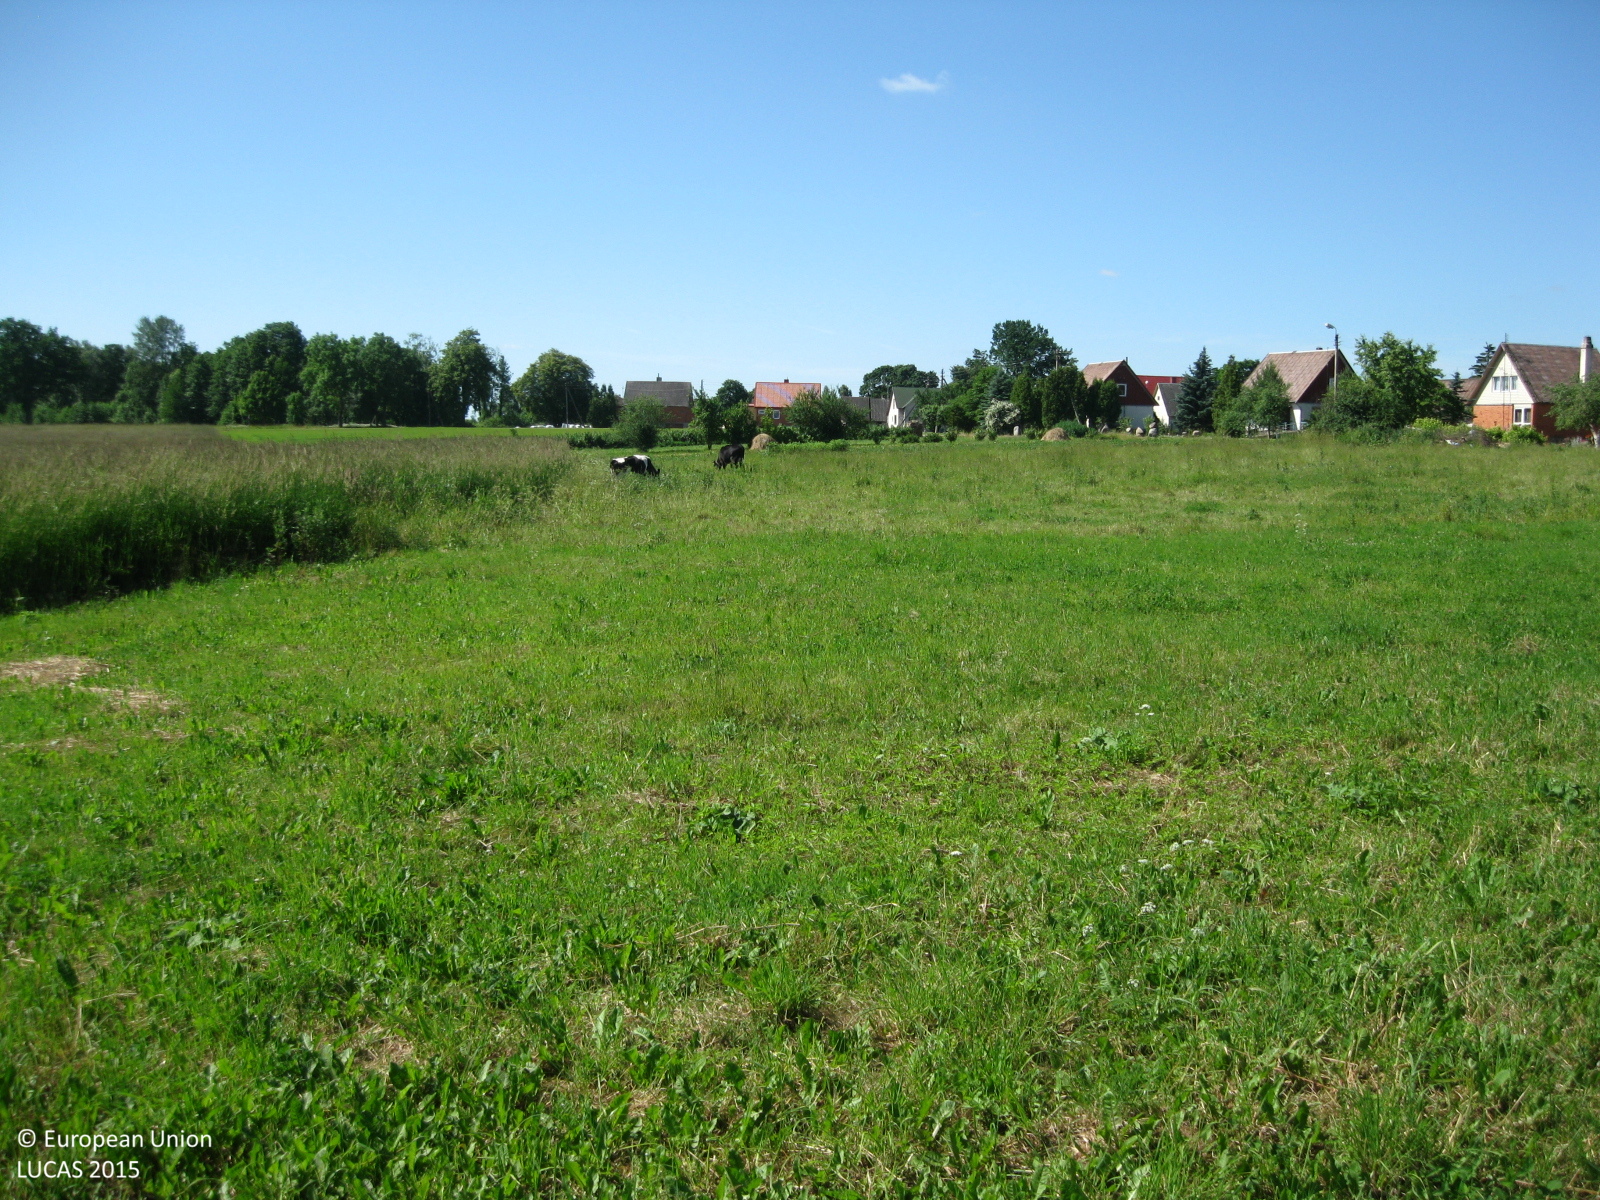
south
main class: Grassland
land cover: Grassland without tree/shrub cover
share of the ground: > 75 %
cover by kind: herbaceous plants 90 %, unconsolidated bare surface 10 %
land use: Agriculture (excluding fallow land and kitchen gardens)
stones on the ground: < 10 %
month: June
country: LT
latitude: 55.4320
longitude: 24.1740
